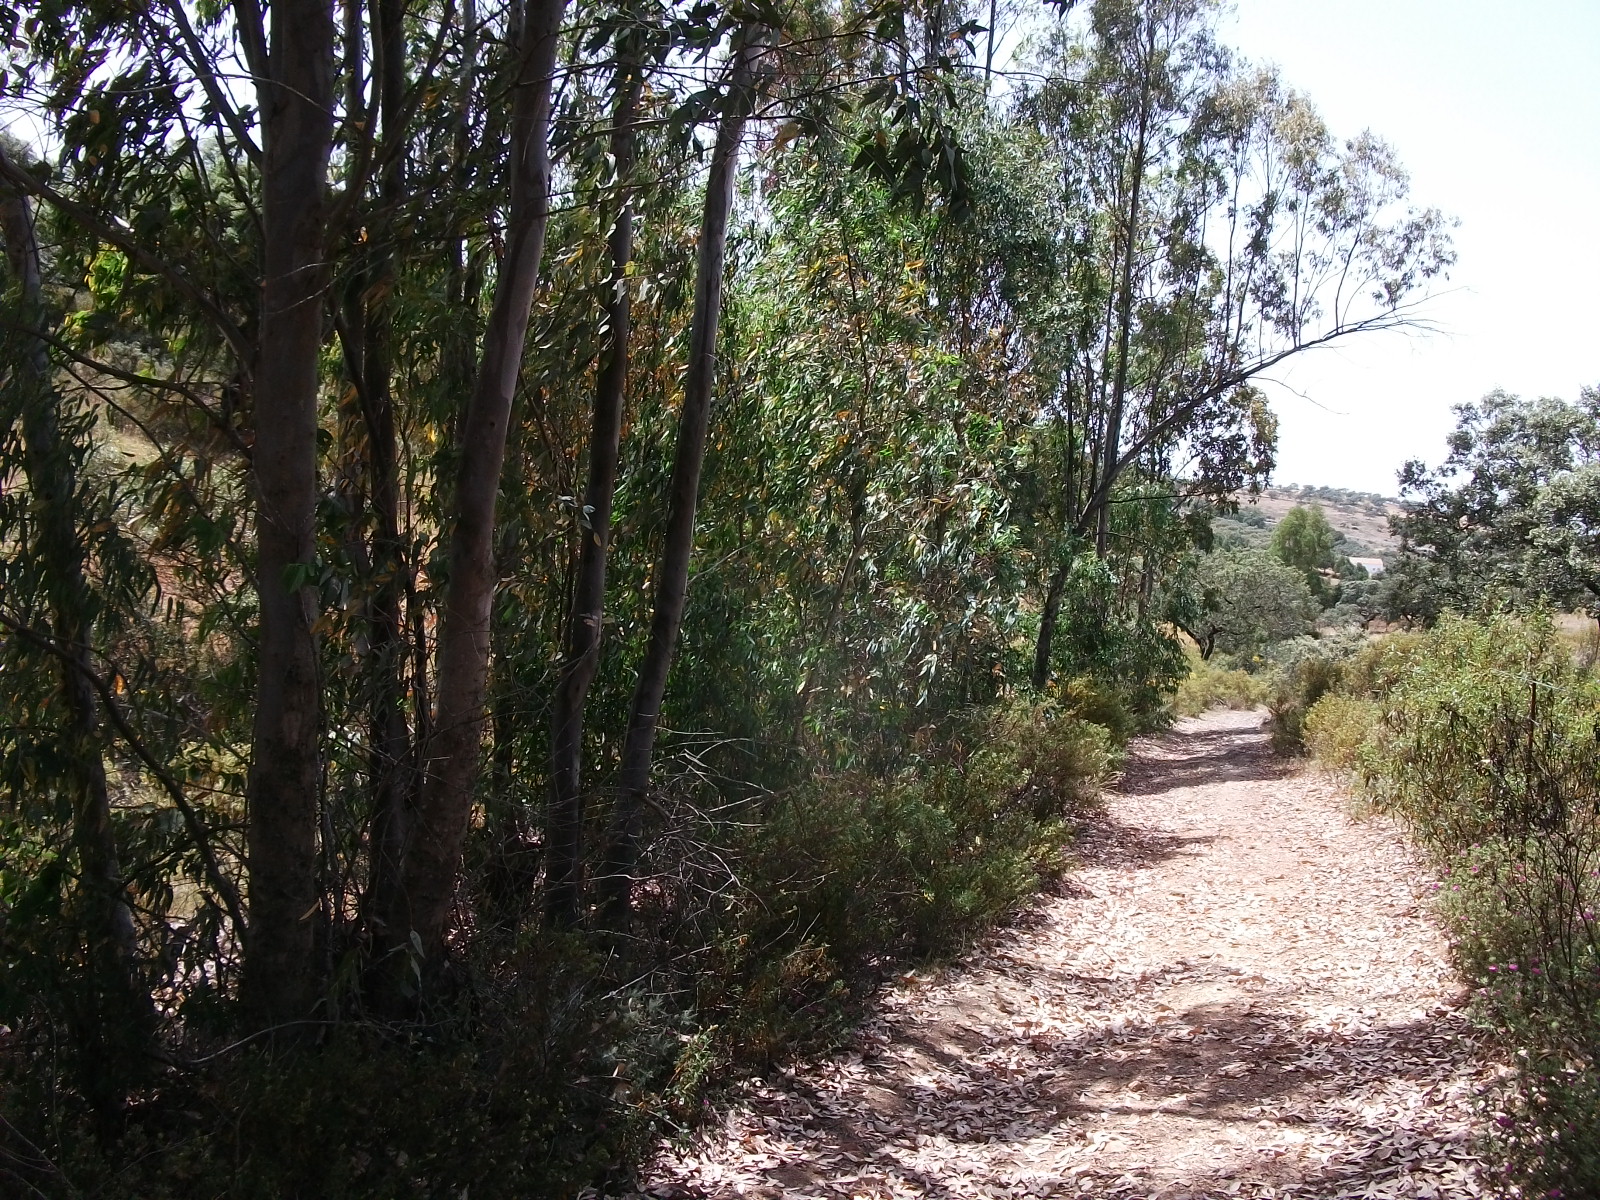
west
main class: Woodland
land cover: Broadleaved woodland
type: broadleaved evergreen forest
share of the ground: 10 - 25 %
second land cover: Shrubland without tree cover
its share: > 75 %
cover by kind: shrubs 70 %, broadleaved forest trees 20 %, herbaceous plants 10 %
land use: Forestry
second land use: Agriculture (excluding fallow land and kitchen gardens)
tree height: > 5 m
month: May
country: ES
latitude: 37.7235
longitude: -7.0797
